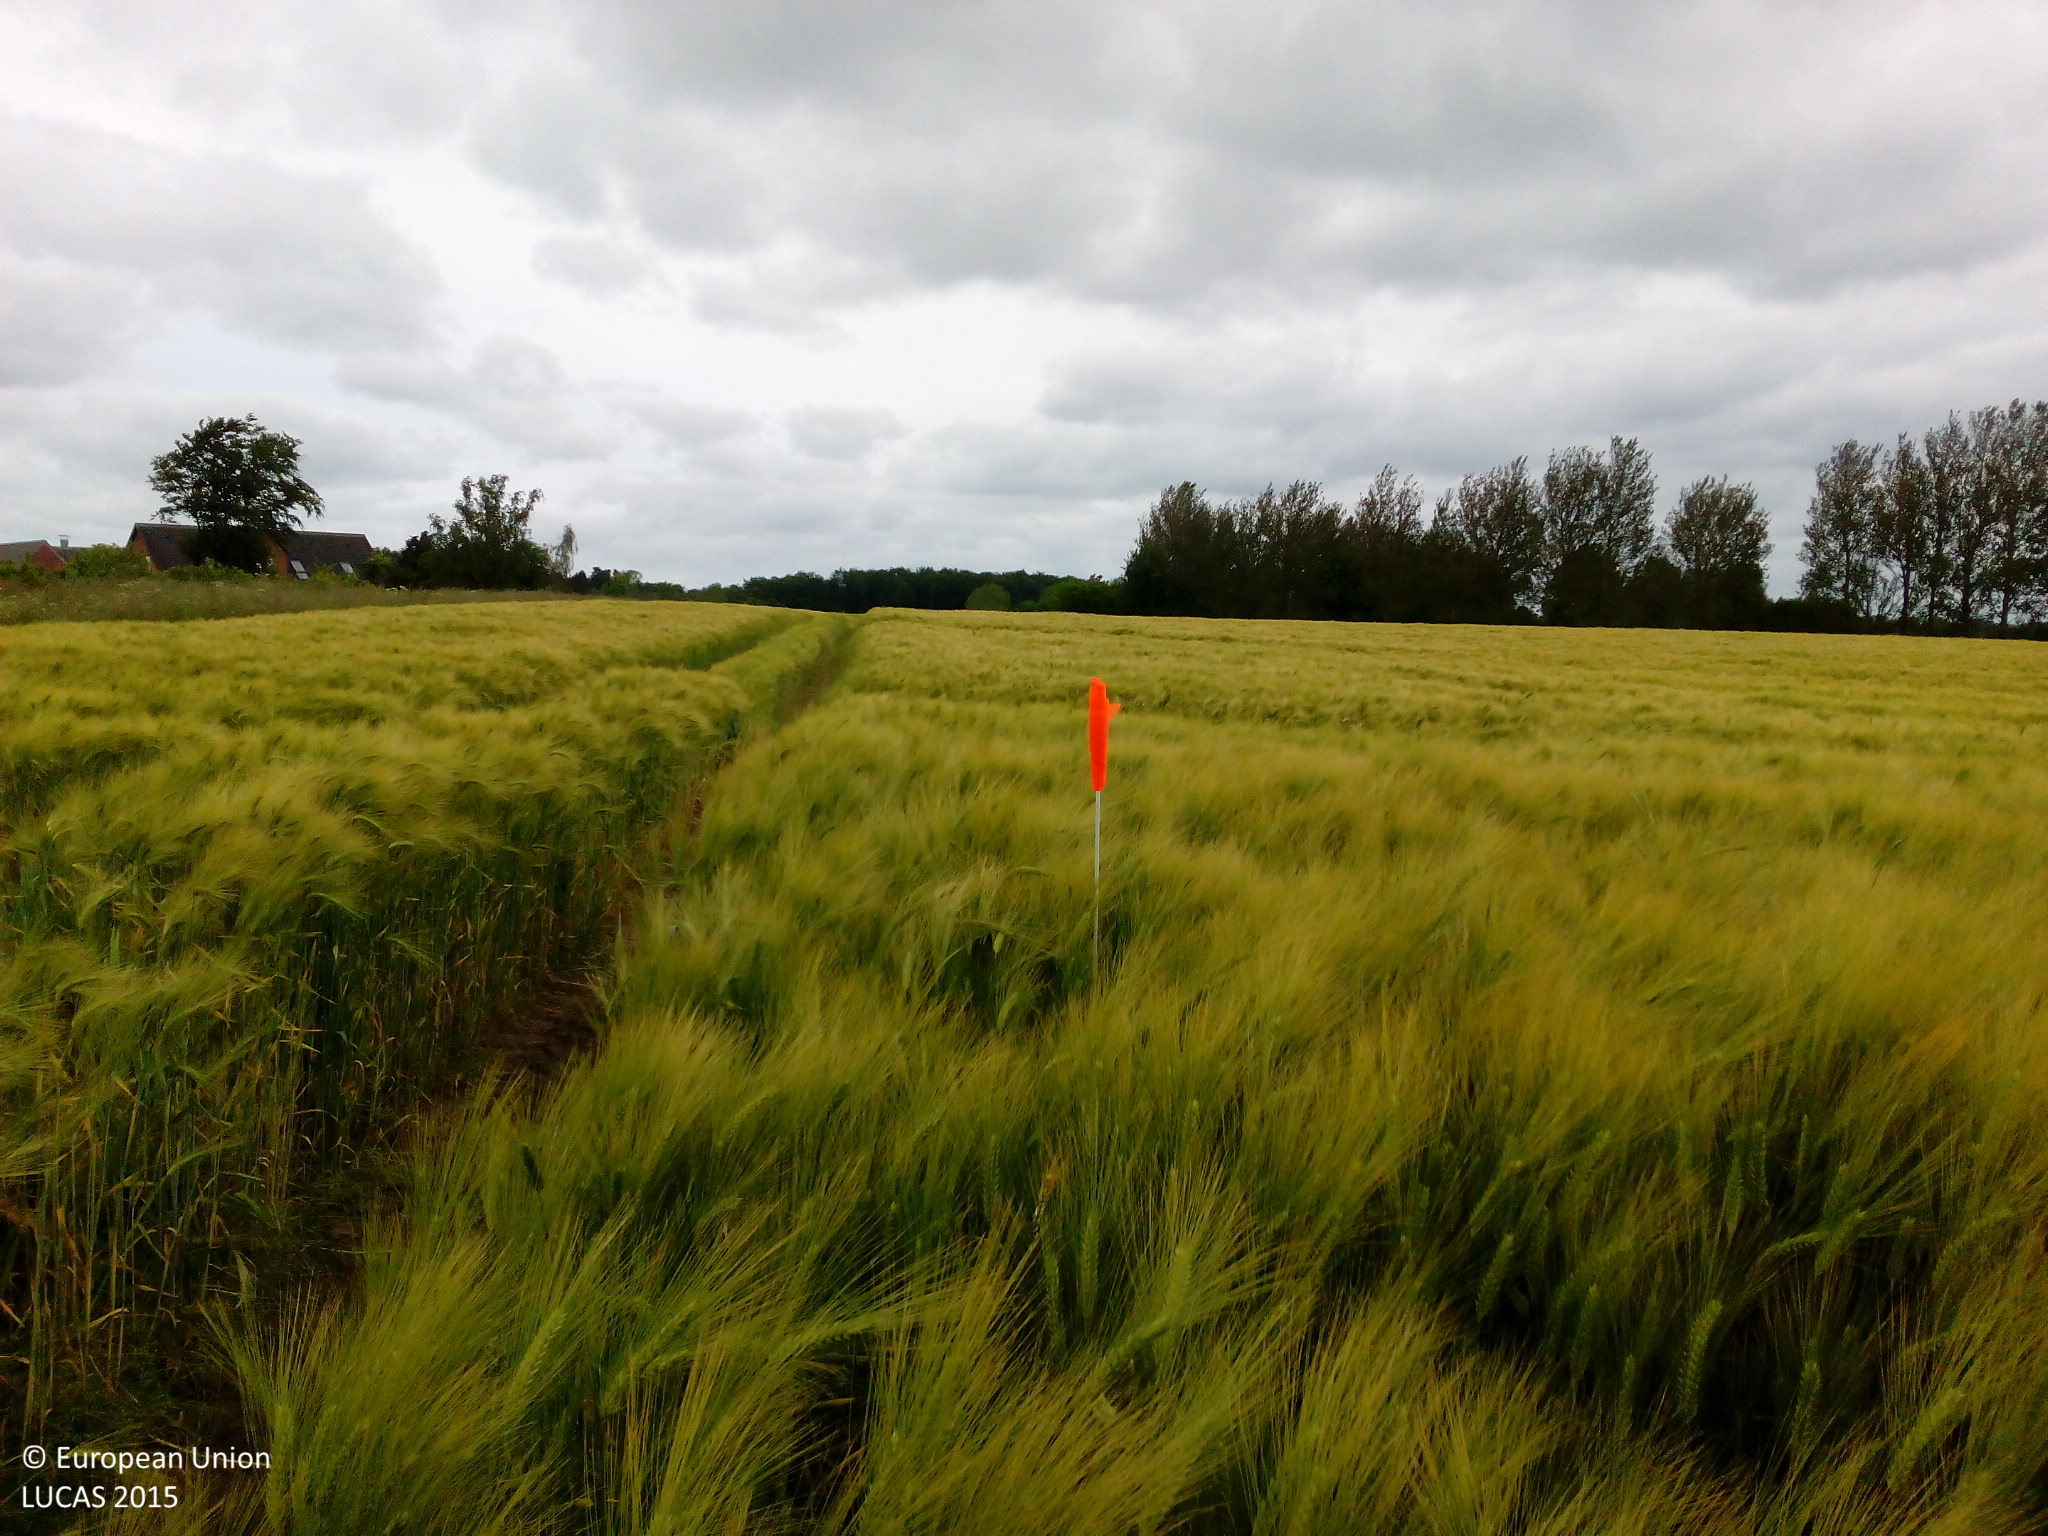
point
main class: Cropland
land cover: Barley
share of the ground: > 75 %
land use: Agriculture (excluding fallow land and kitchen gardens)
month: June
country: DK
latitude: 55.1968
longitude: 10.7691
